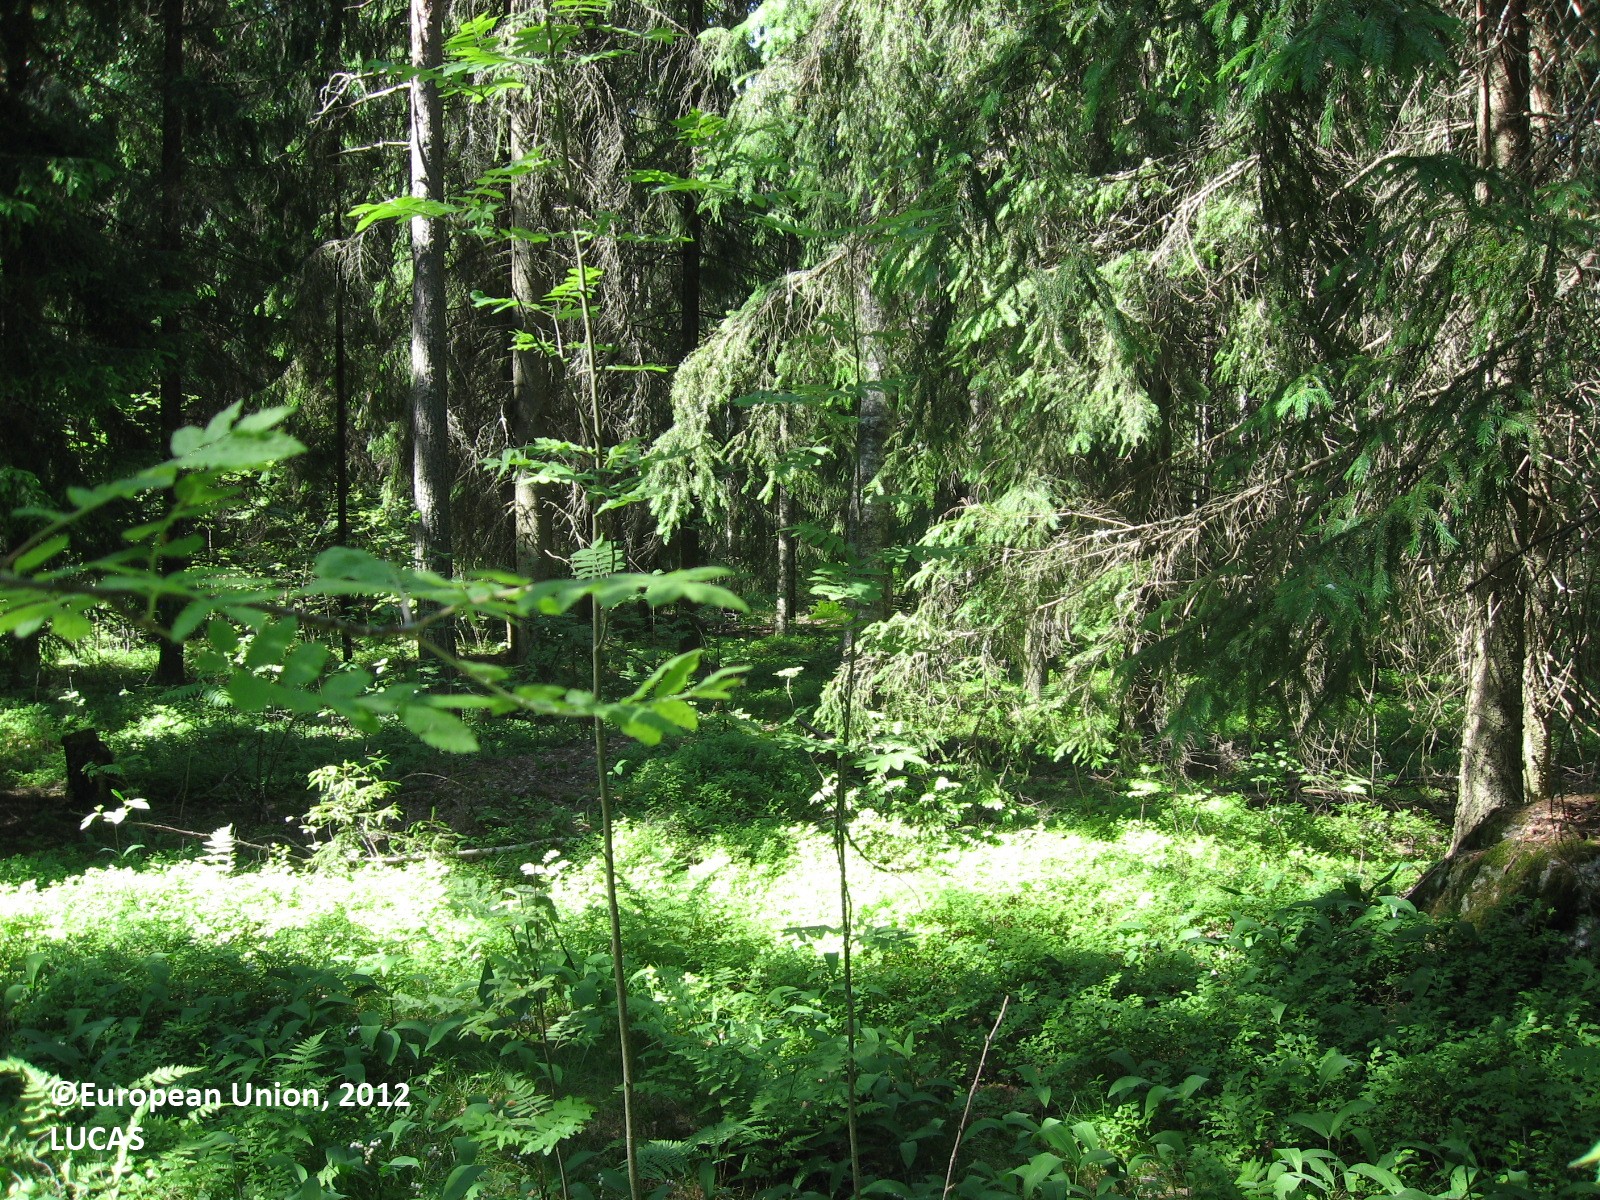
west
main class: Woodland
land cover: Spruce dominated mixed woodland
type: boreal forest
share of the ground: > 75 %
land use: Forestry
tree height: > 5 m
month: June
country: FI
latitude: 60.5643
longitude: 25.0208
